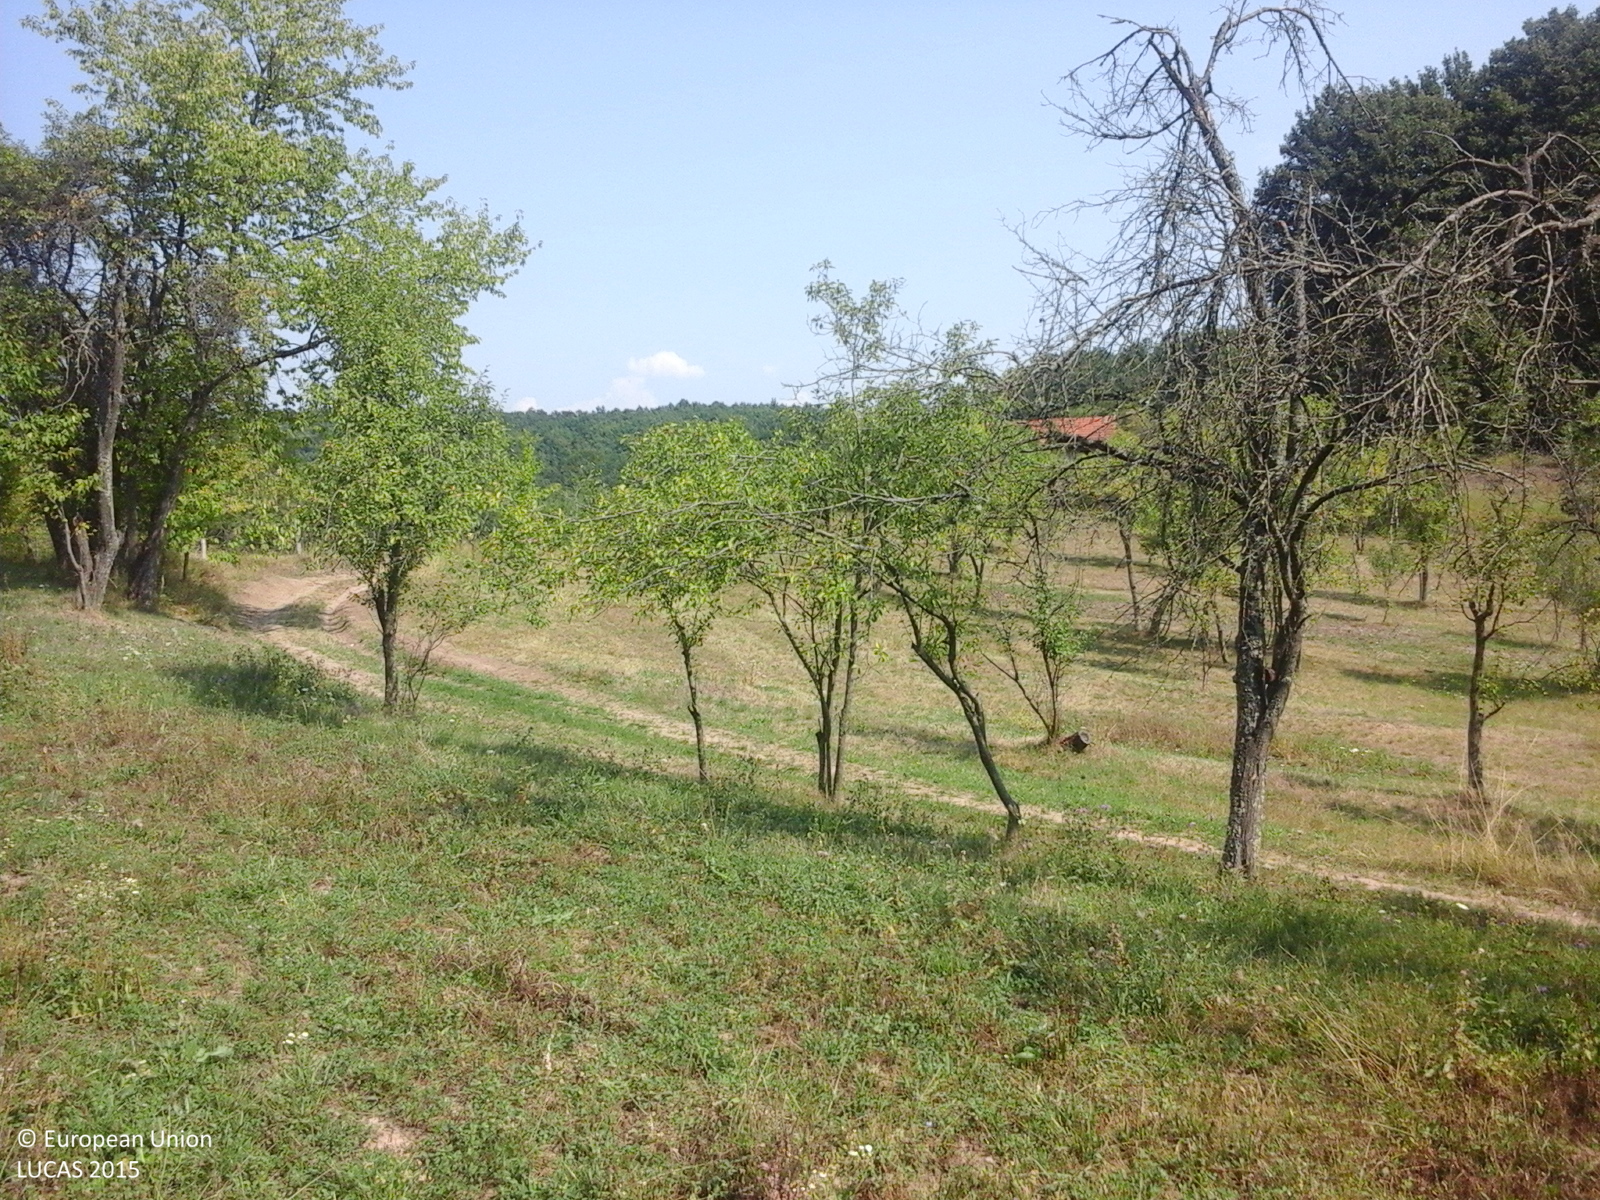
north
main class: Cropland
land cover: Maize
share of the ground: > 75 %
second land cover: Other fresh vegetables
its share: 25 - 50 %
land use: Agriculture (excluding fallow land and kitchen gardens)
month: August
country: RO
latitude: 46.1429
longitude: 22.8056
